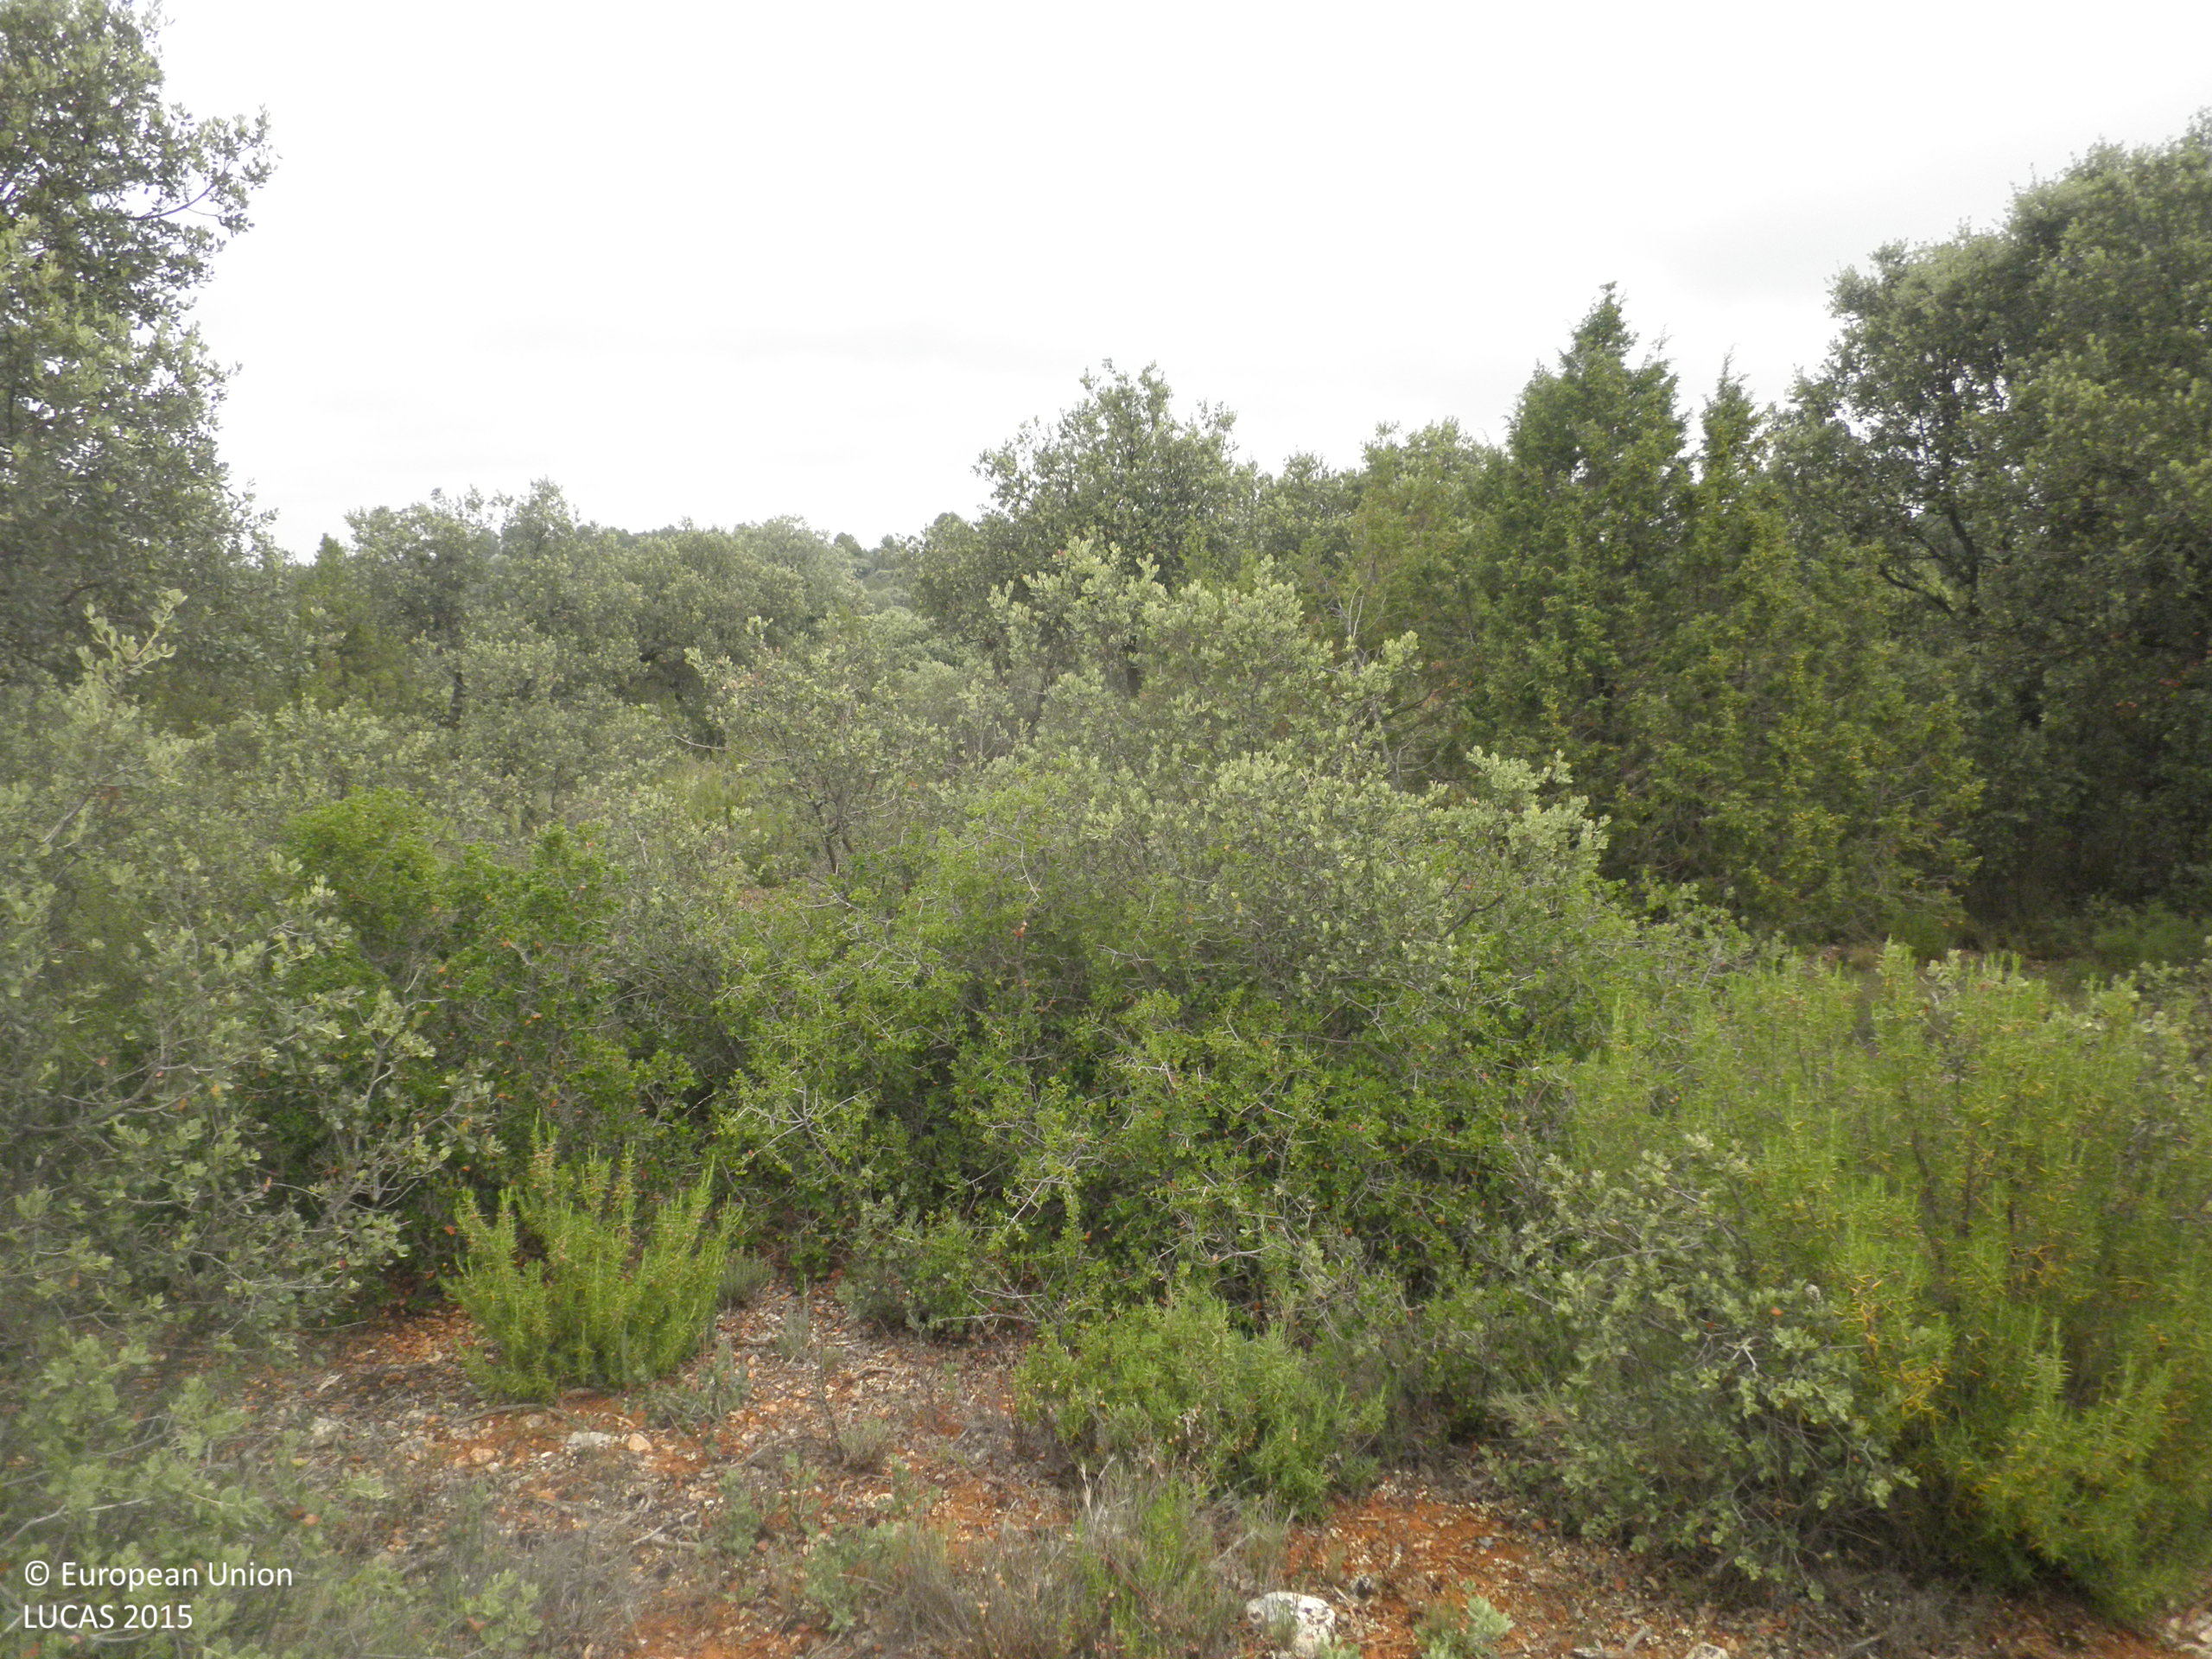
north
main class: Woodland
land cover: Broadleaved woodland
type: broadleaved evergreen forest
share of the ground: 25 - 50 %
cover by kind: shrubs 35 %, unconsolidated bare surface 30 %, broadleaved forest trees 25 %, herbaceous plants 10 %
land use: Semi-natural and natural areas not in use
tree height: < 5 m
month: June
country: ES
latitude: 39.5642
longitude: -1.7041
